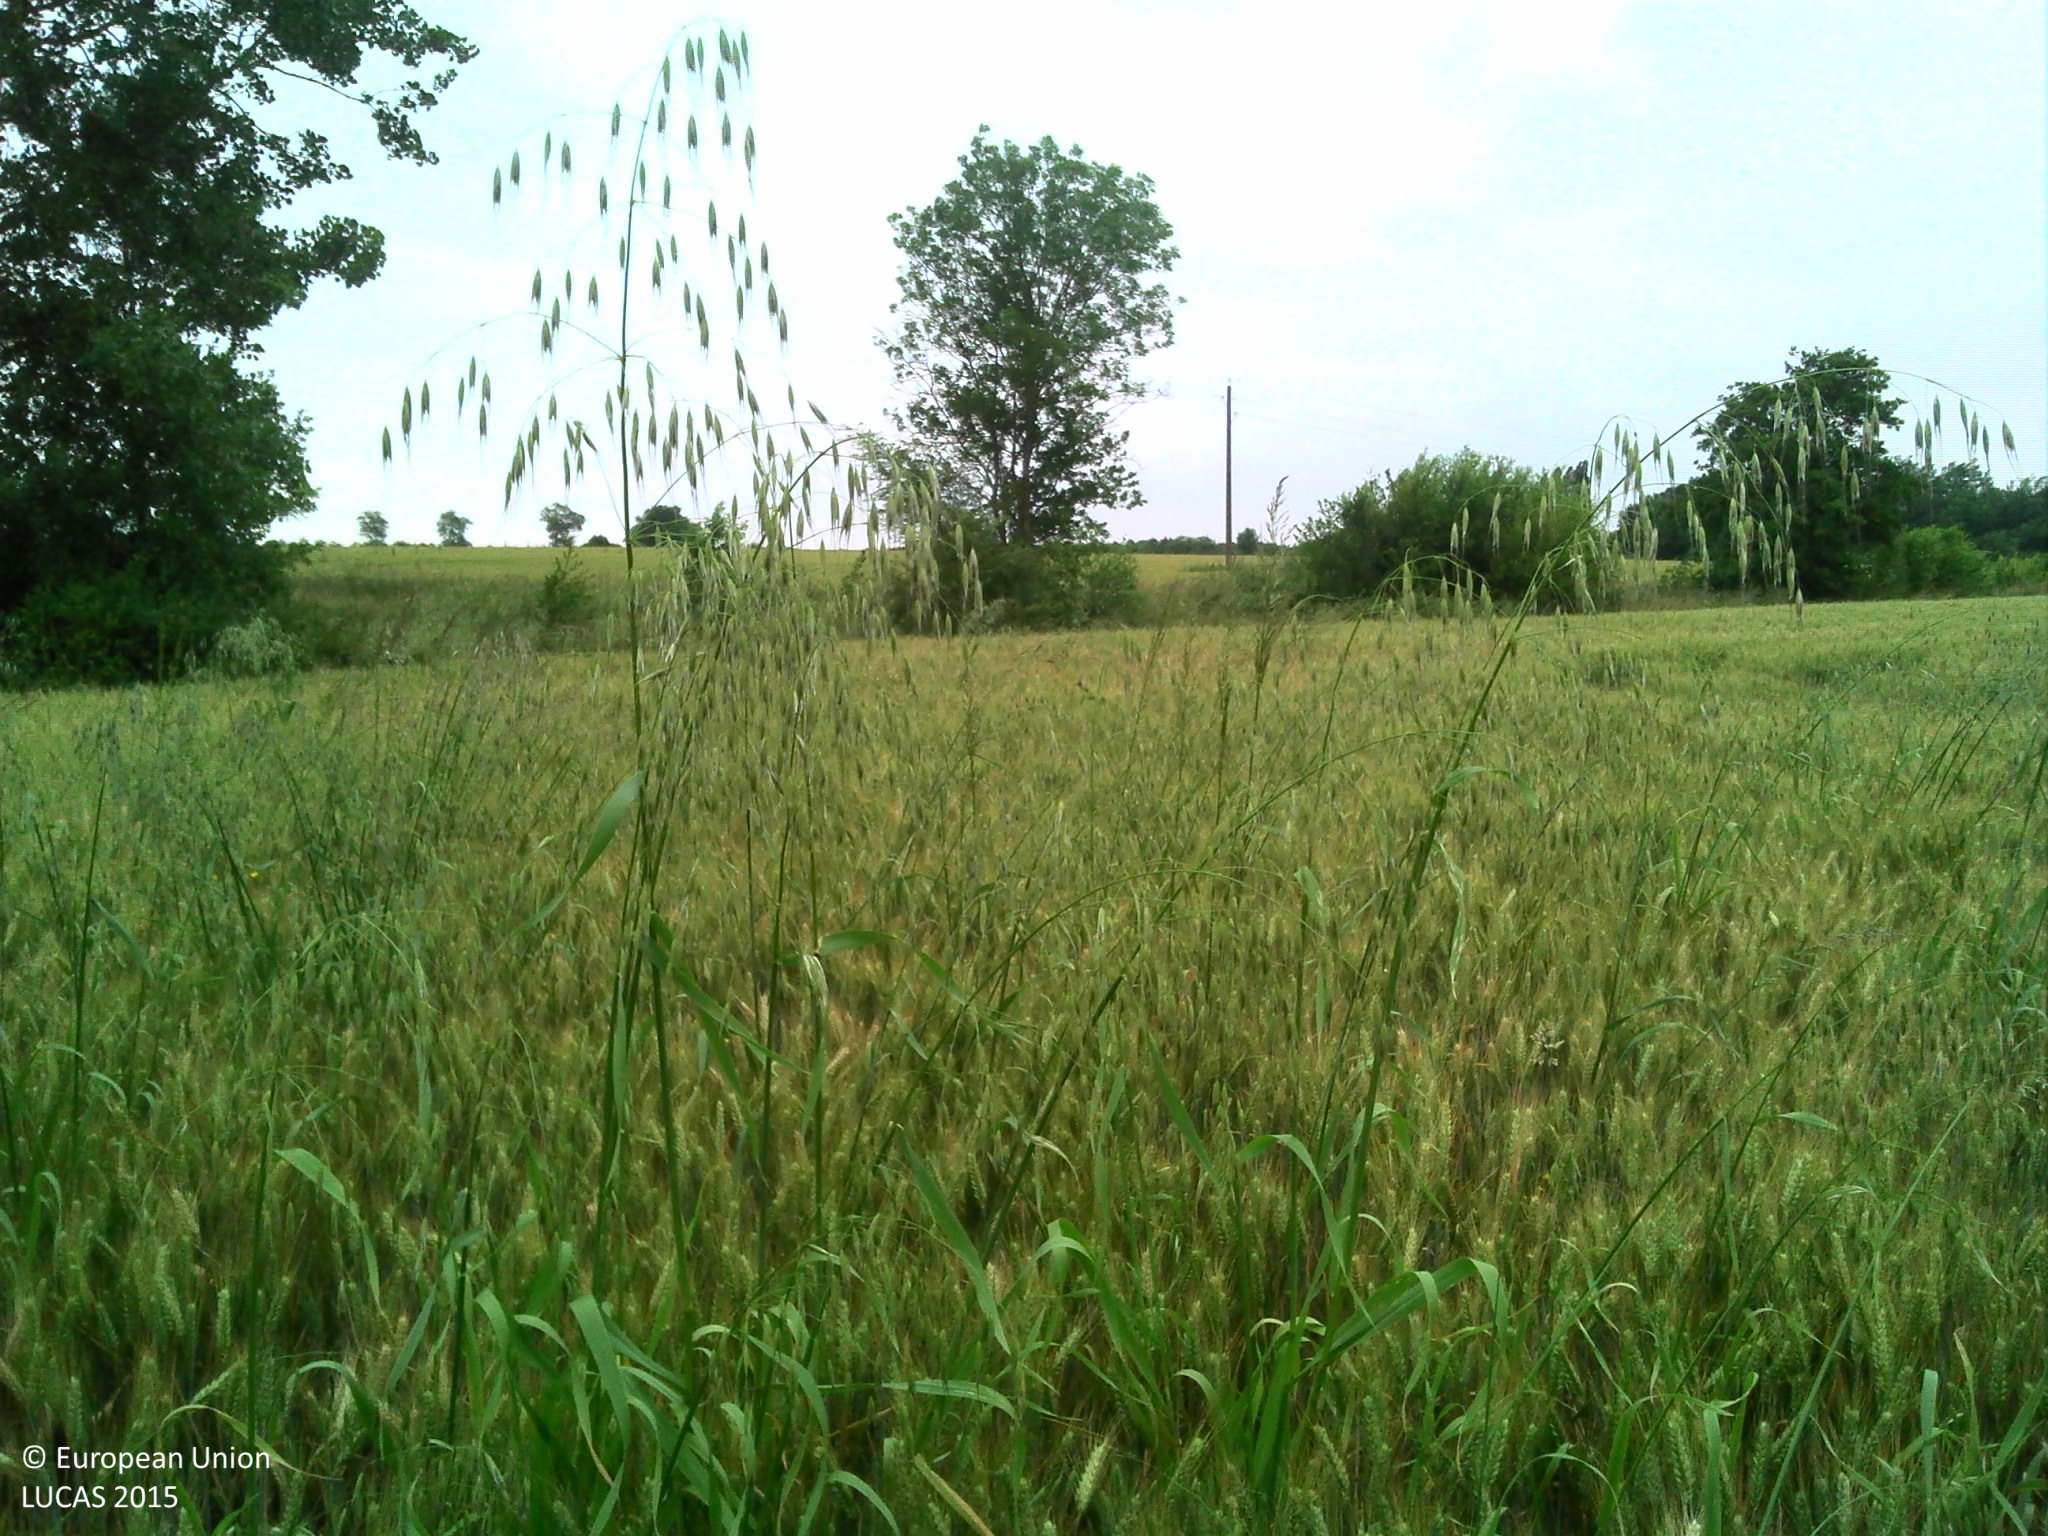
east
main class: Cropland
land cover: Common wheat
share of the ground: > 75 %
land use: Agriculture (excluding fallow land and kitchen gardens)
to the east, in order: Grass margins; Common wheat; Tracks; Grass margins; Ditches and canals; Grass margins; Temporary grasslands; Fences; Ditches and canals; Grass margins; Electric lines; Ditches and canals; Grass margins; Common wheat; Fences; Grassland without tree/shrub cover
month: June
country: FR
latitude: 46.9665
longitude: -1.4875
